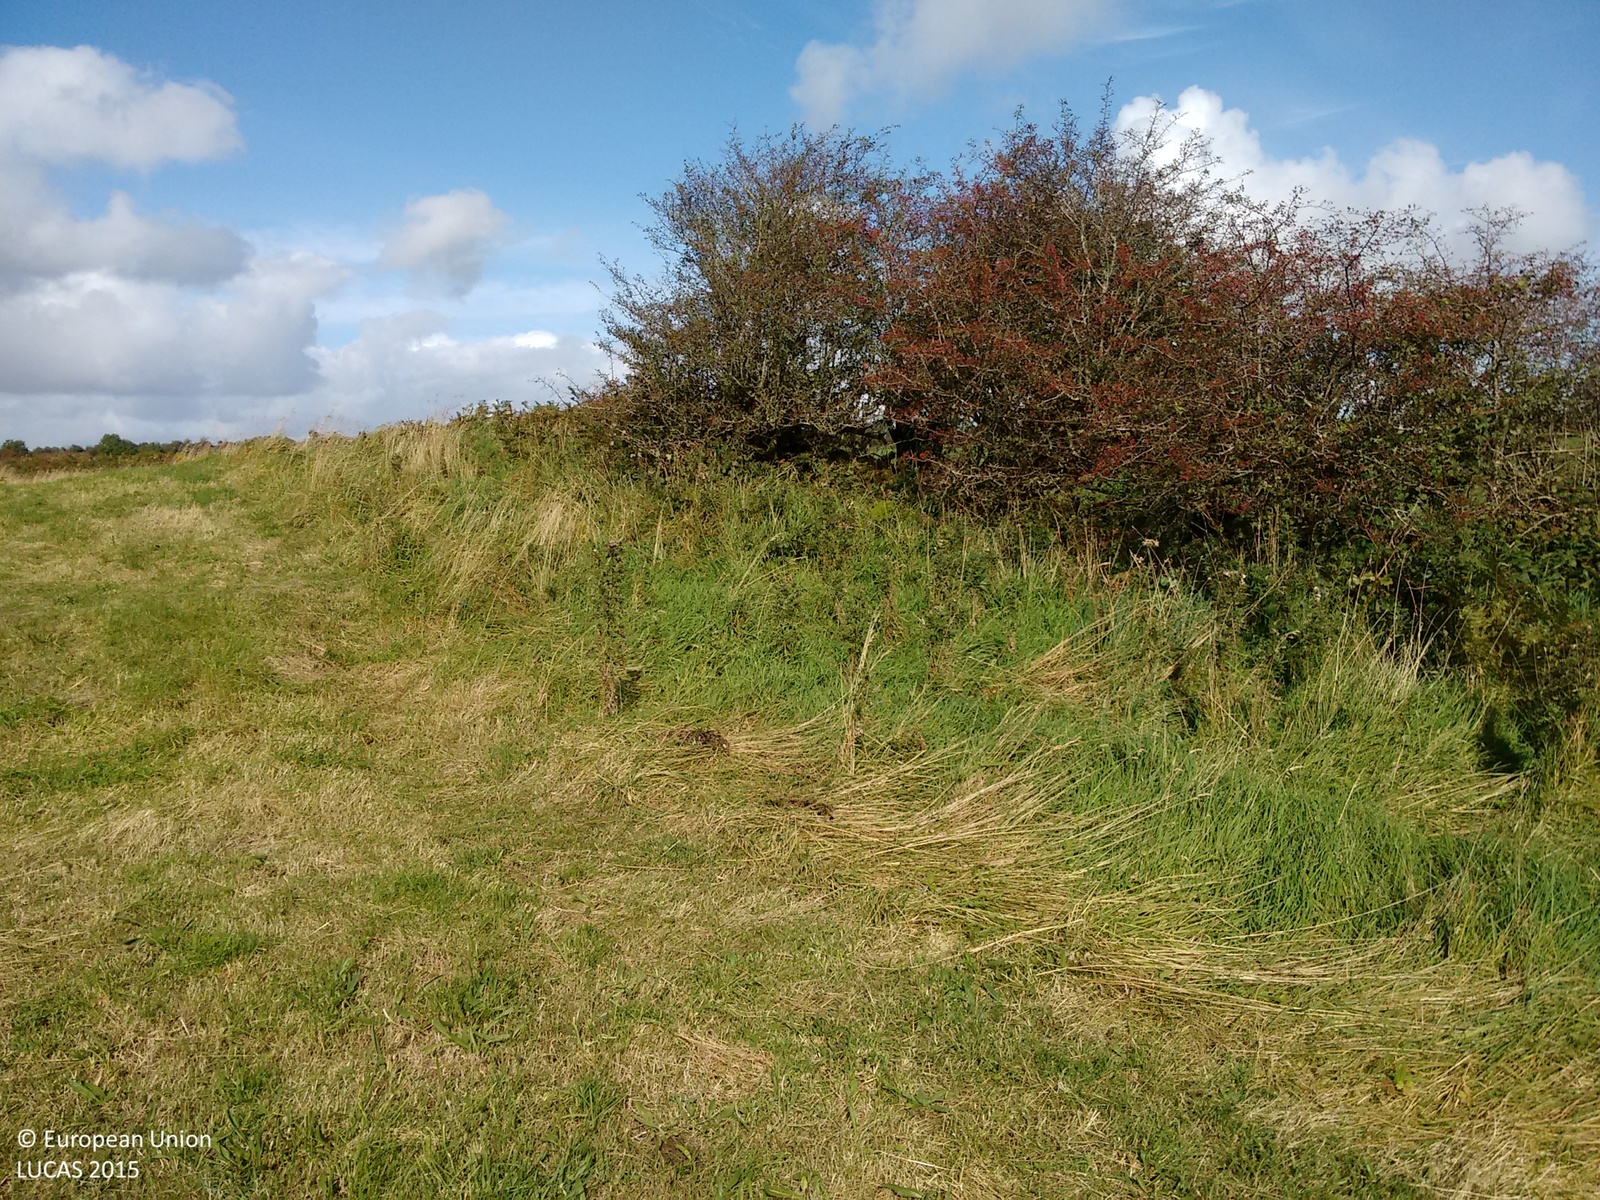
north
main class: Grassland
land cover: Grassland without tree/shrub cover
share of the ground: > 75 %
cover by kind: herbaceous plants 100 %
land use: Agriculture (excluding fallow land and kitchen gardens)
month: September
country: IE
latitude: 53.8134
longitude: -8.8095
